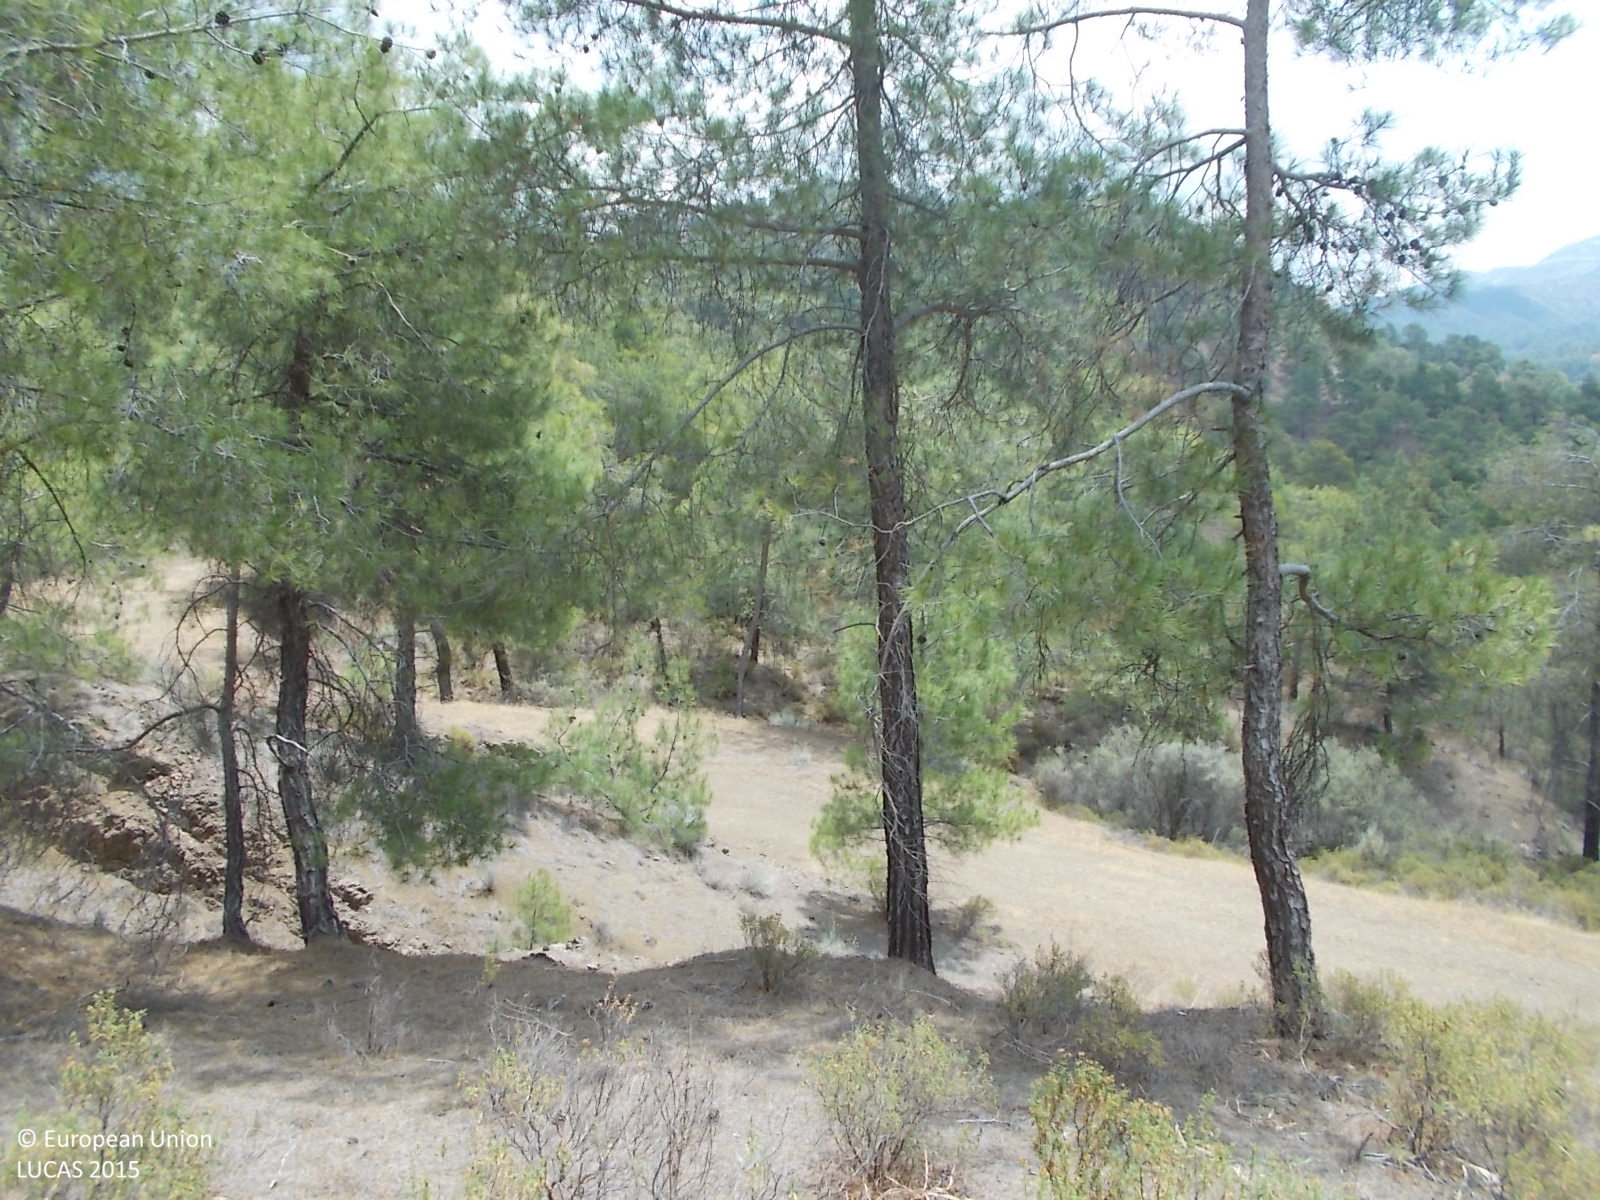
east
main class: Woodland
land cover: Pine dominated coniferous woodland
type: coniferous forest of the mediterranean region
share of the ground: 50 - 75 %
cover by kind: coniferous forest trees 70 %, unconsolidated bare surface 20 %, shrubs 10 %
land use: Forestry
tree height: > 5 m
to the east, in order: Pine dominated coniferous woodland; Tracks; Pine dominated coniferous woodland; Rivers and streams; Pine dominated coniferous woodland
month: June
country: CY
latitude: 34.8932
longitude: 32.7574
